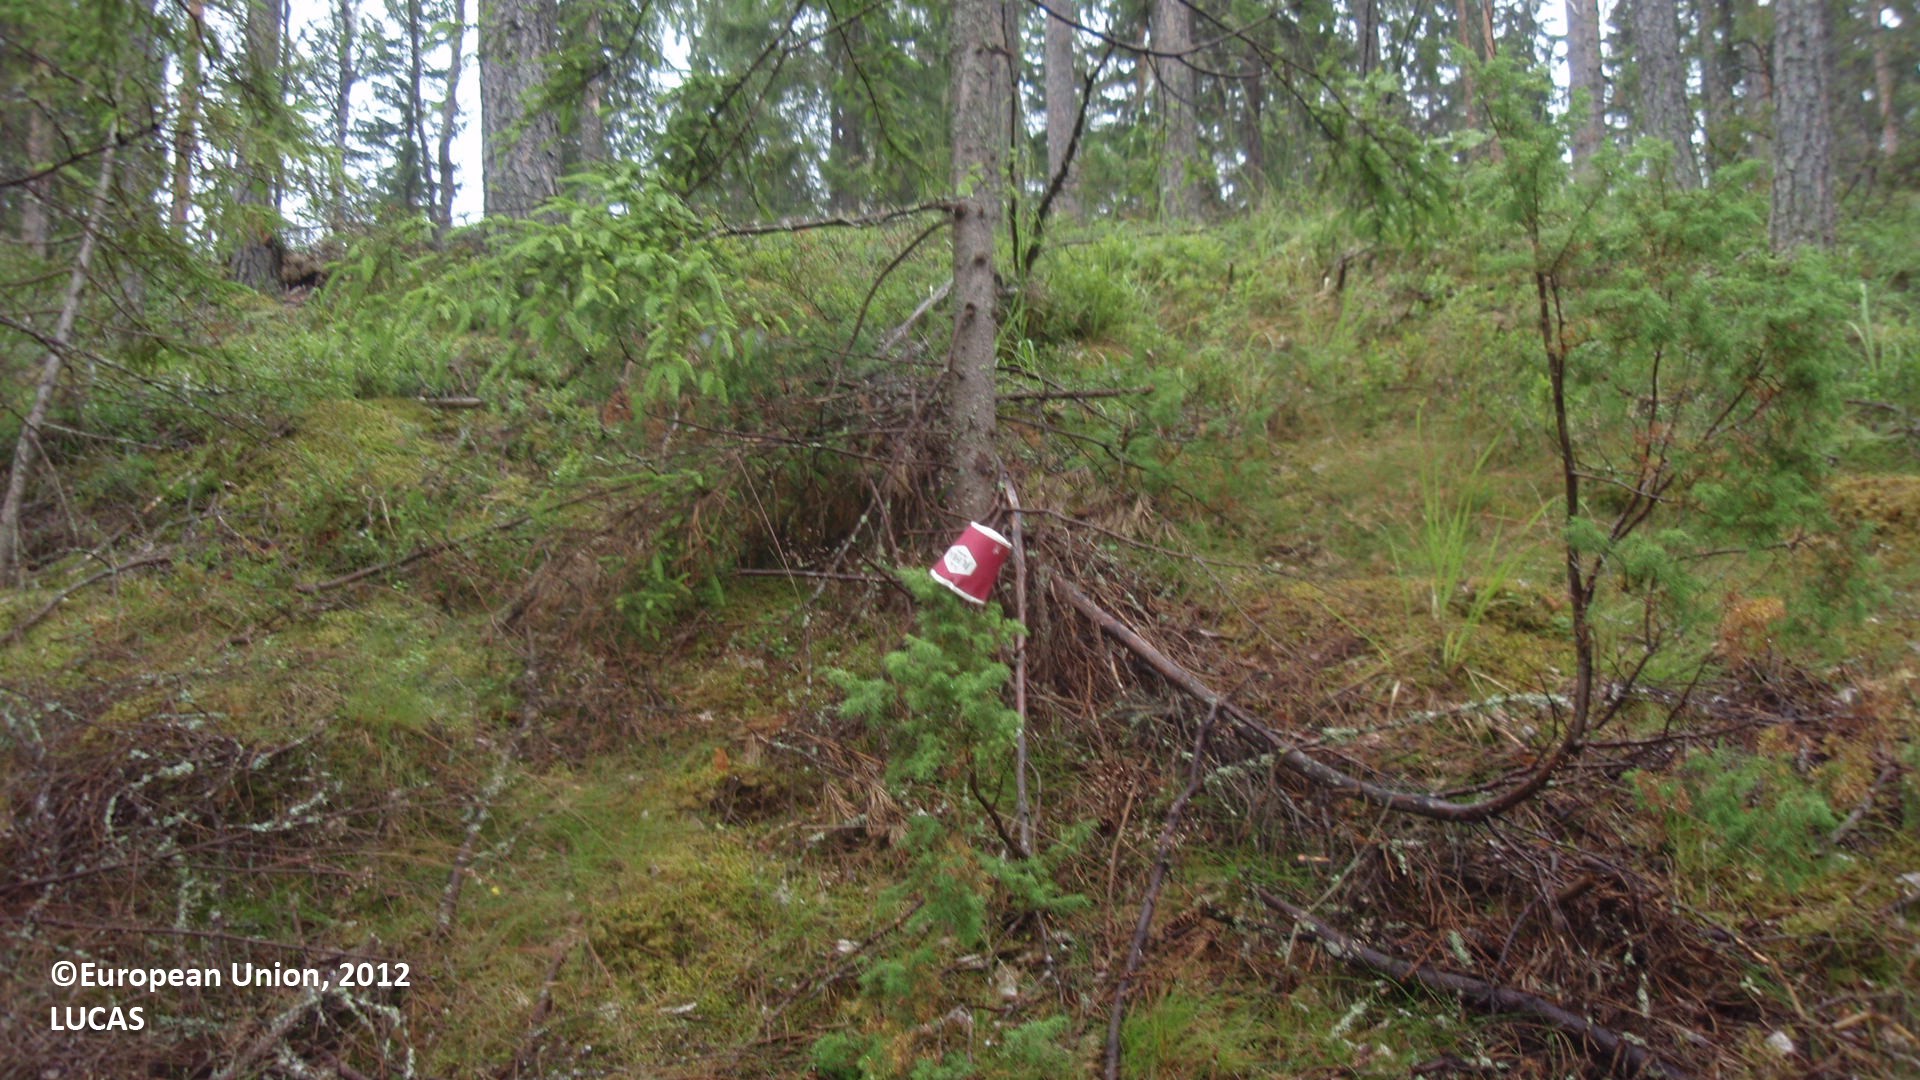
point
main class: Woodland
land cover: Pine dominated mixed woodland
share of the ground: 25 - 50 %
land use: Forestry
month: July
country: FI
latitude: 61.1207
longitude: 28.7297
